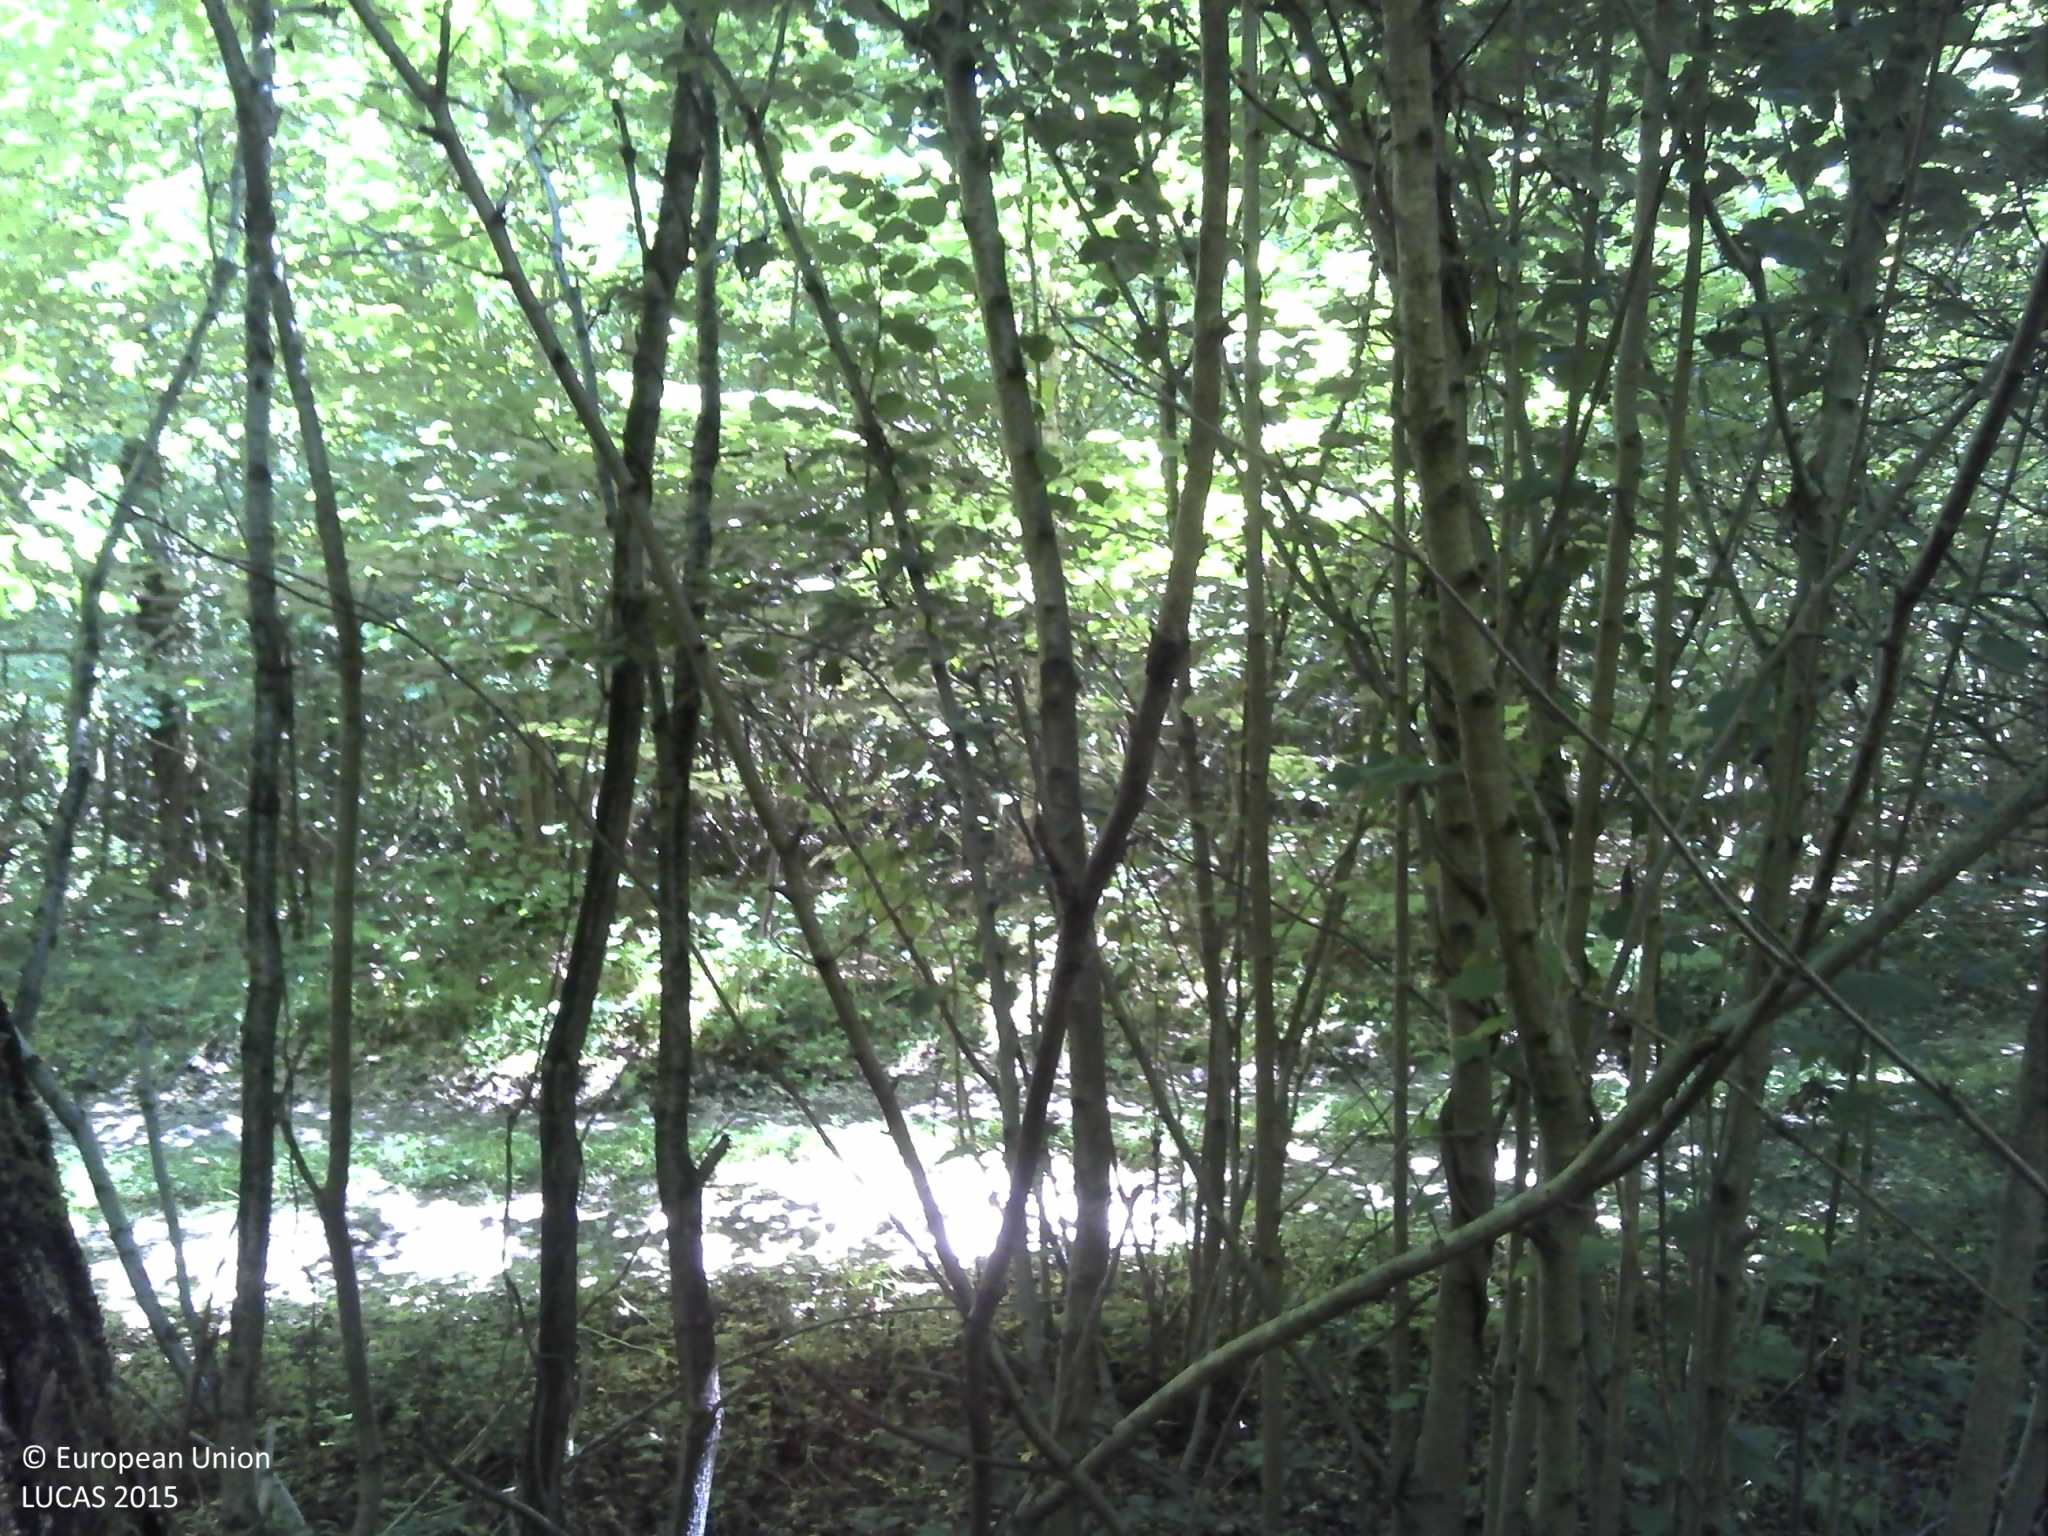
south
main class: Woodland
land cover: Broadleaved woodland
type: acidophilous oak and oak-birch forest
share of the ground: > 75 %
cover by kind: broadleaved forest trees 70 %, herbaceous plants 15 %, consolidated bare surface 10 %, lichens and mosses 5 %
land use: Forestry
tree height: > 5 m
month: June
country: FR
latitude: 50.0291
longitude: 4.7899
